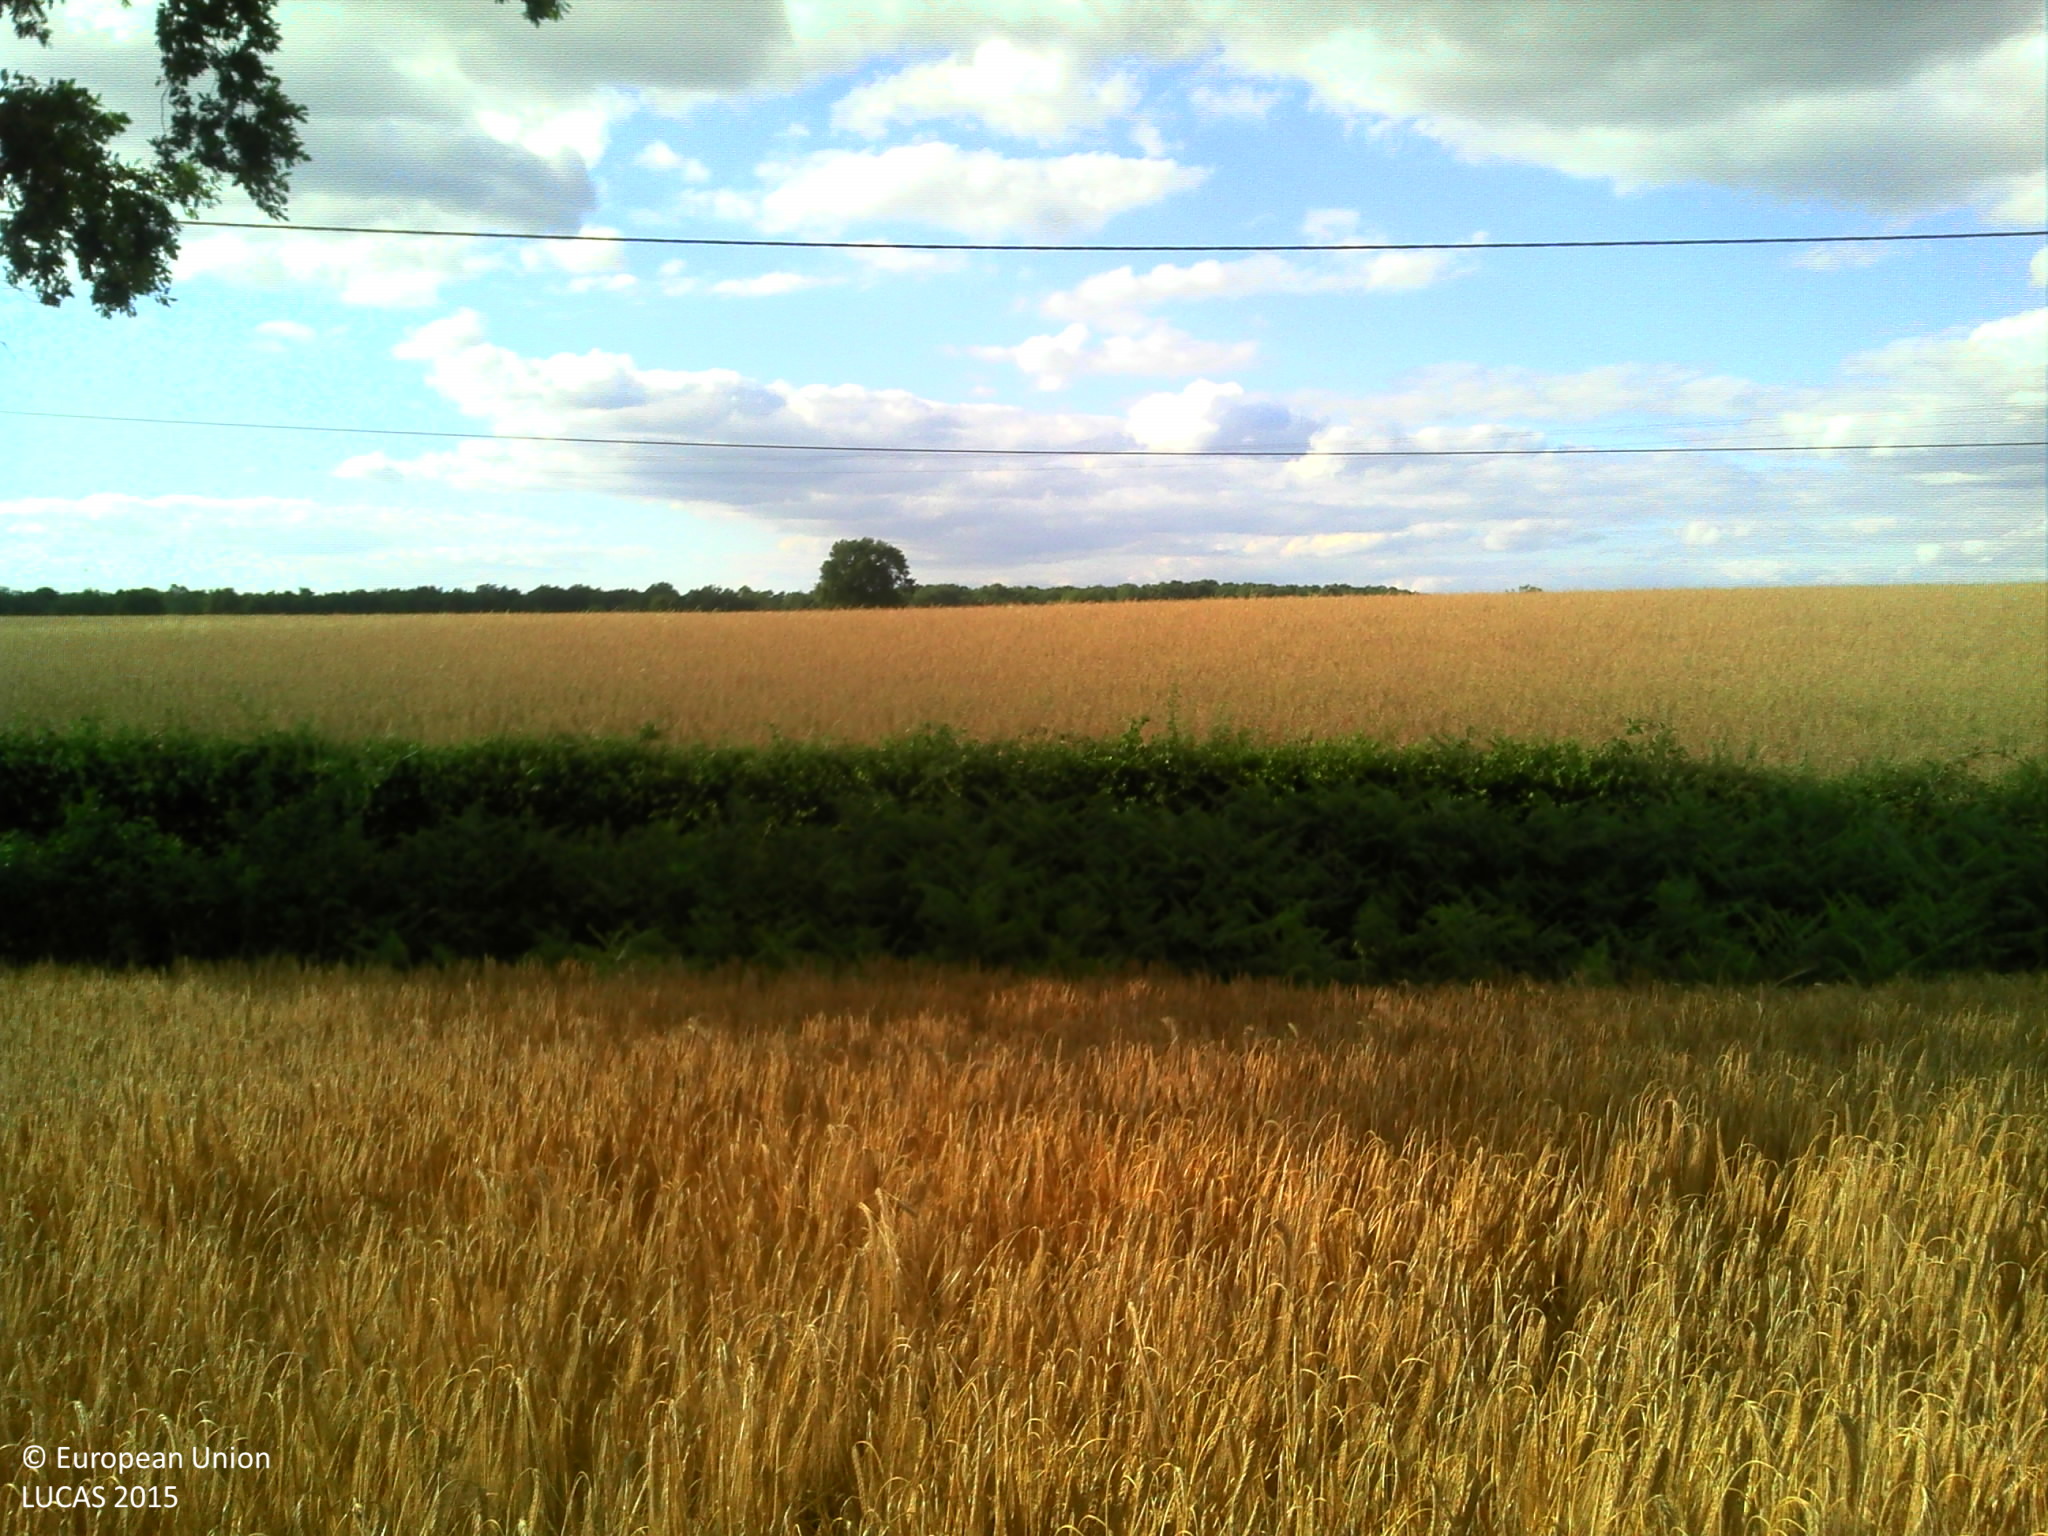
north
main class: Cropland
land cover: Barley
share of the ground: > 75 %
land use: Agriculture (excluding fallow land and kitchen gardens)
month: June
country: FR
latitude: 46.4220
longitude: 4.0803
